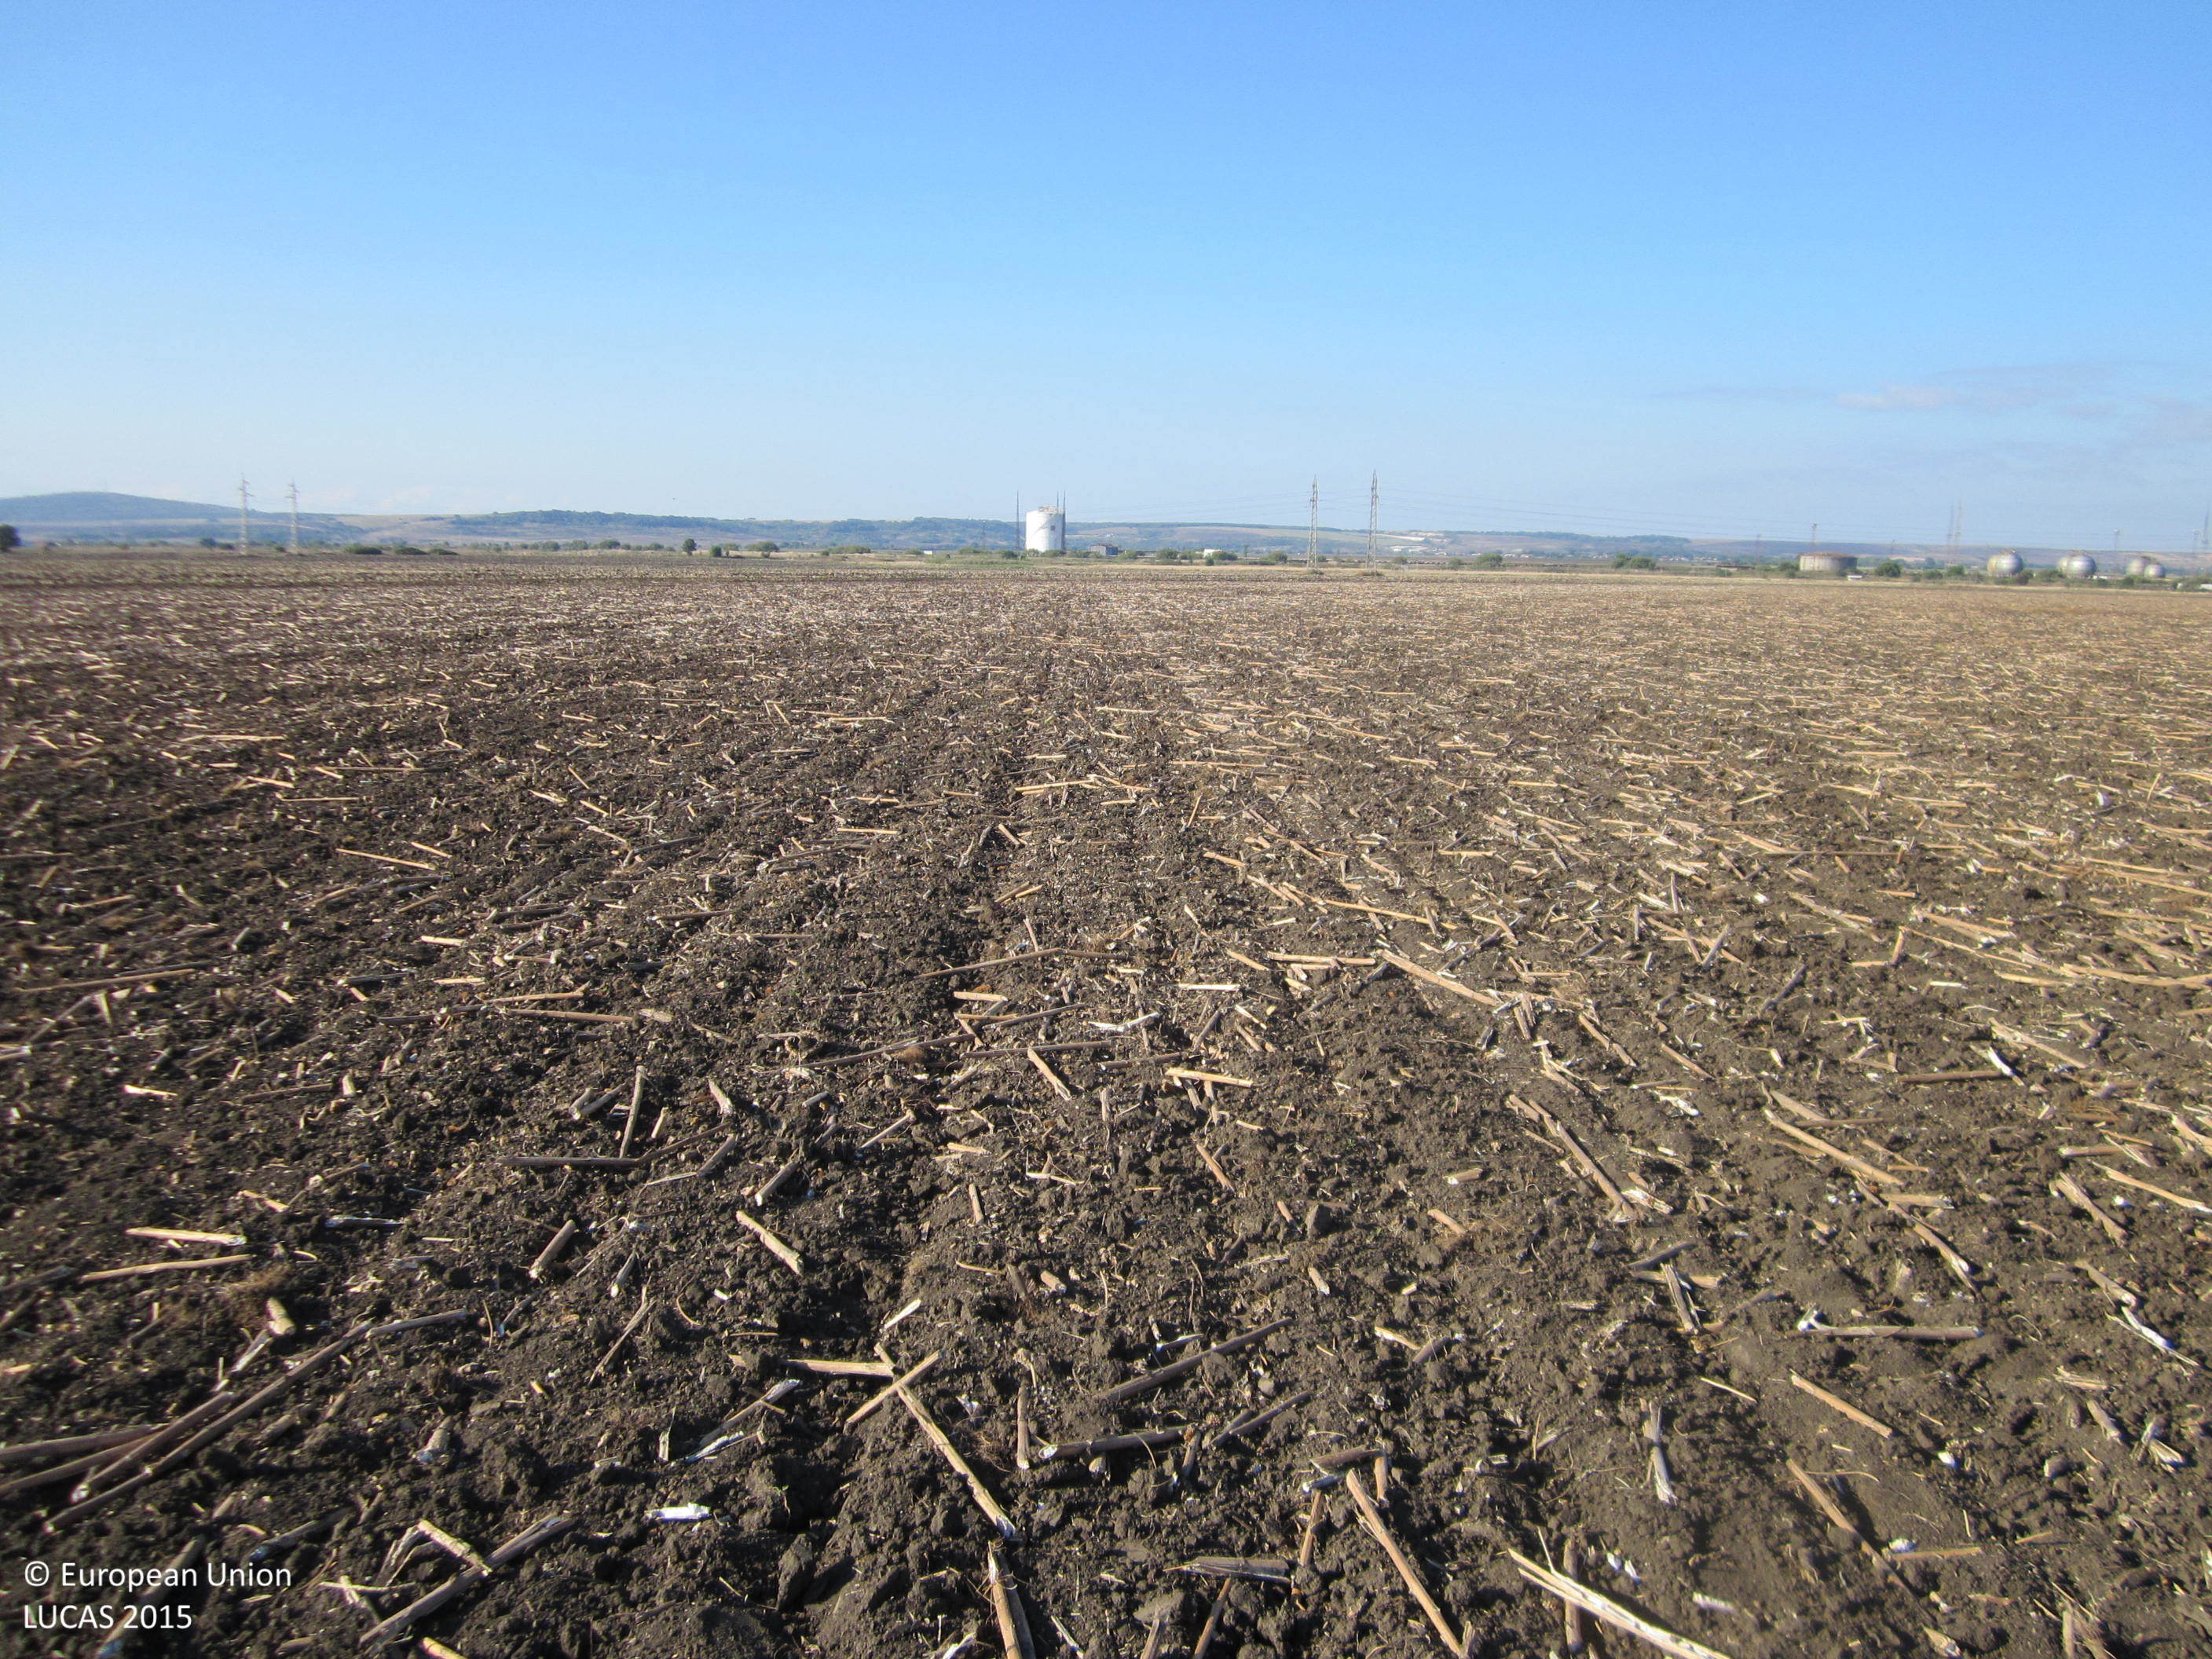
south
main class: Cropland
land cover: Sunflower
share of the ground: < 10 %
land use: Agriculture (excluding fallow land and kitchen gardens)
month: September
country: BG
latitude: 42.5270
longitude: 27.3397
